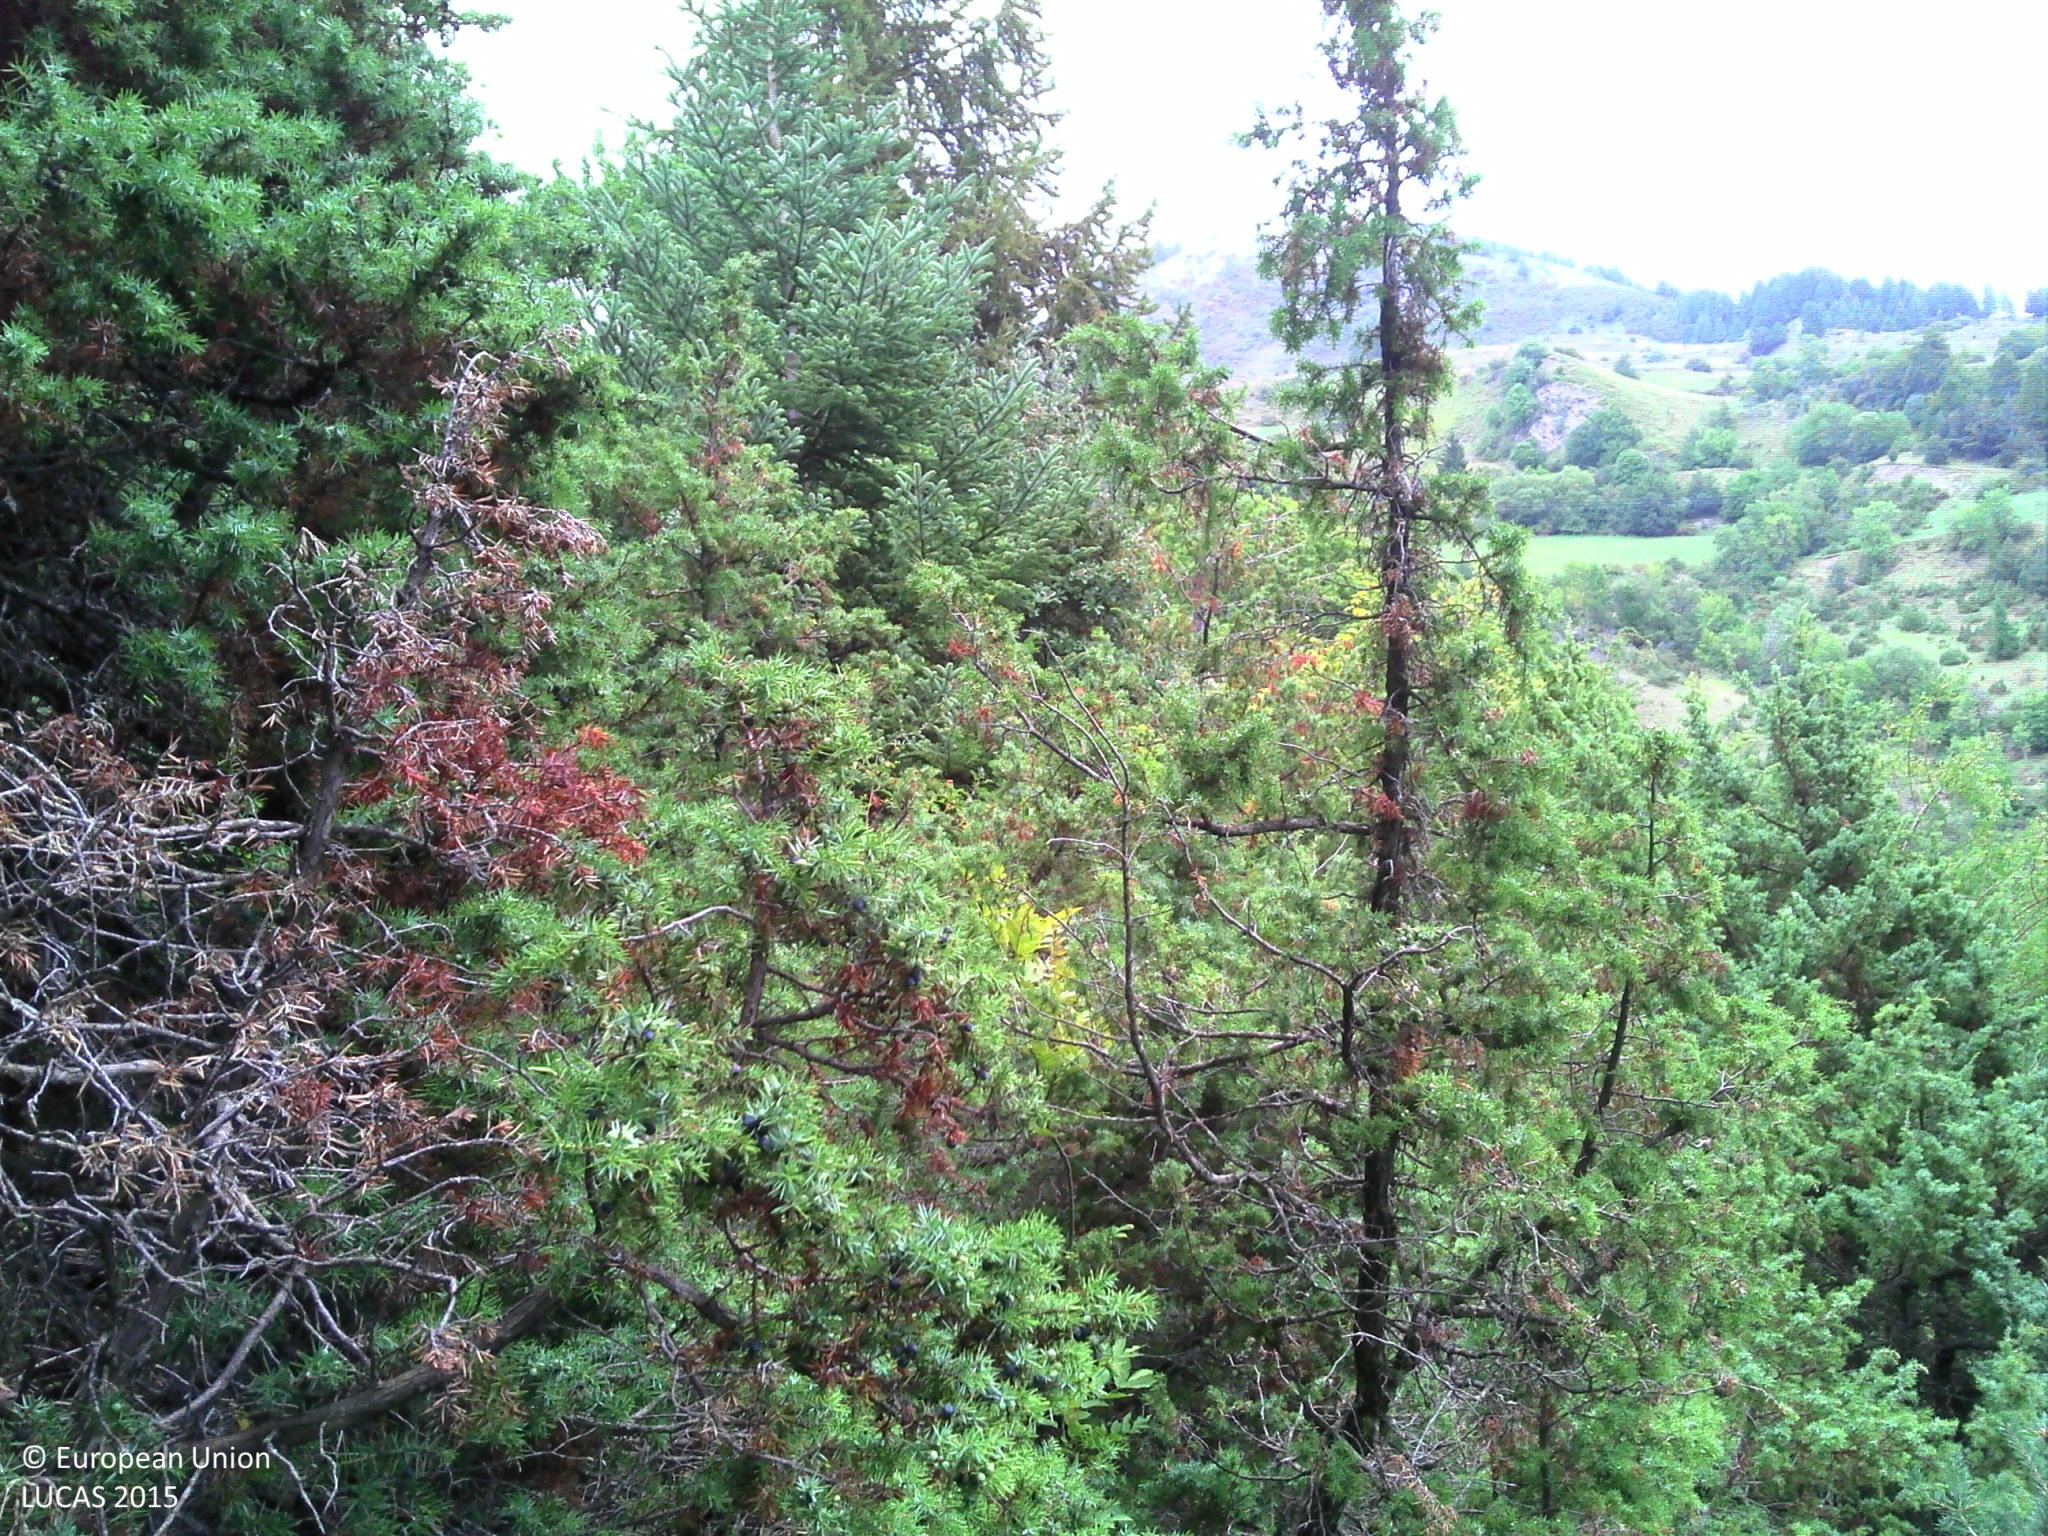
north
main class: Woodland
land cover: Other mixed woodland
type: hemiboreal forest and nemoral coniferous forest and mixed broadleaved-coniferous forest
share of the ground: > 75 %
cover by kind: coniferous forest trees 60 %, broadleaved forest trees 25 %, shrubs 10 %, herbaceous plants 5 %
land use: Forestry
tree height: > 5 m
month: September
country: FR
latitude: 44.6794
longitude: 6.2342
